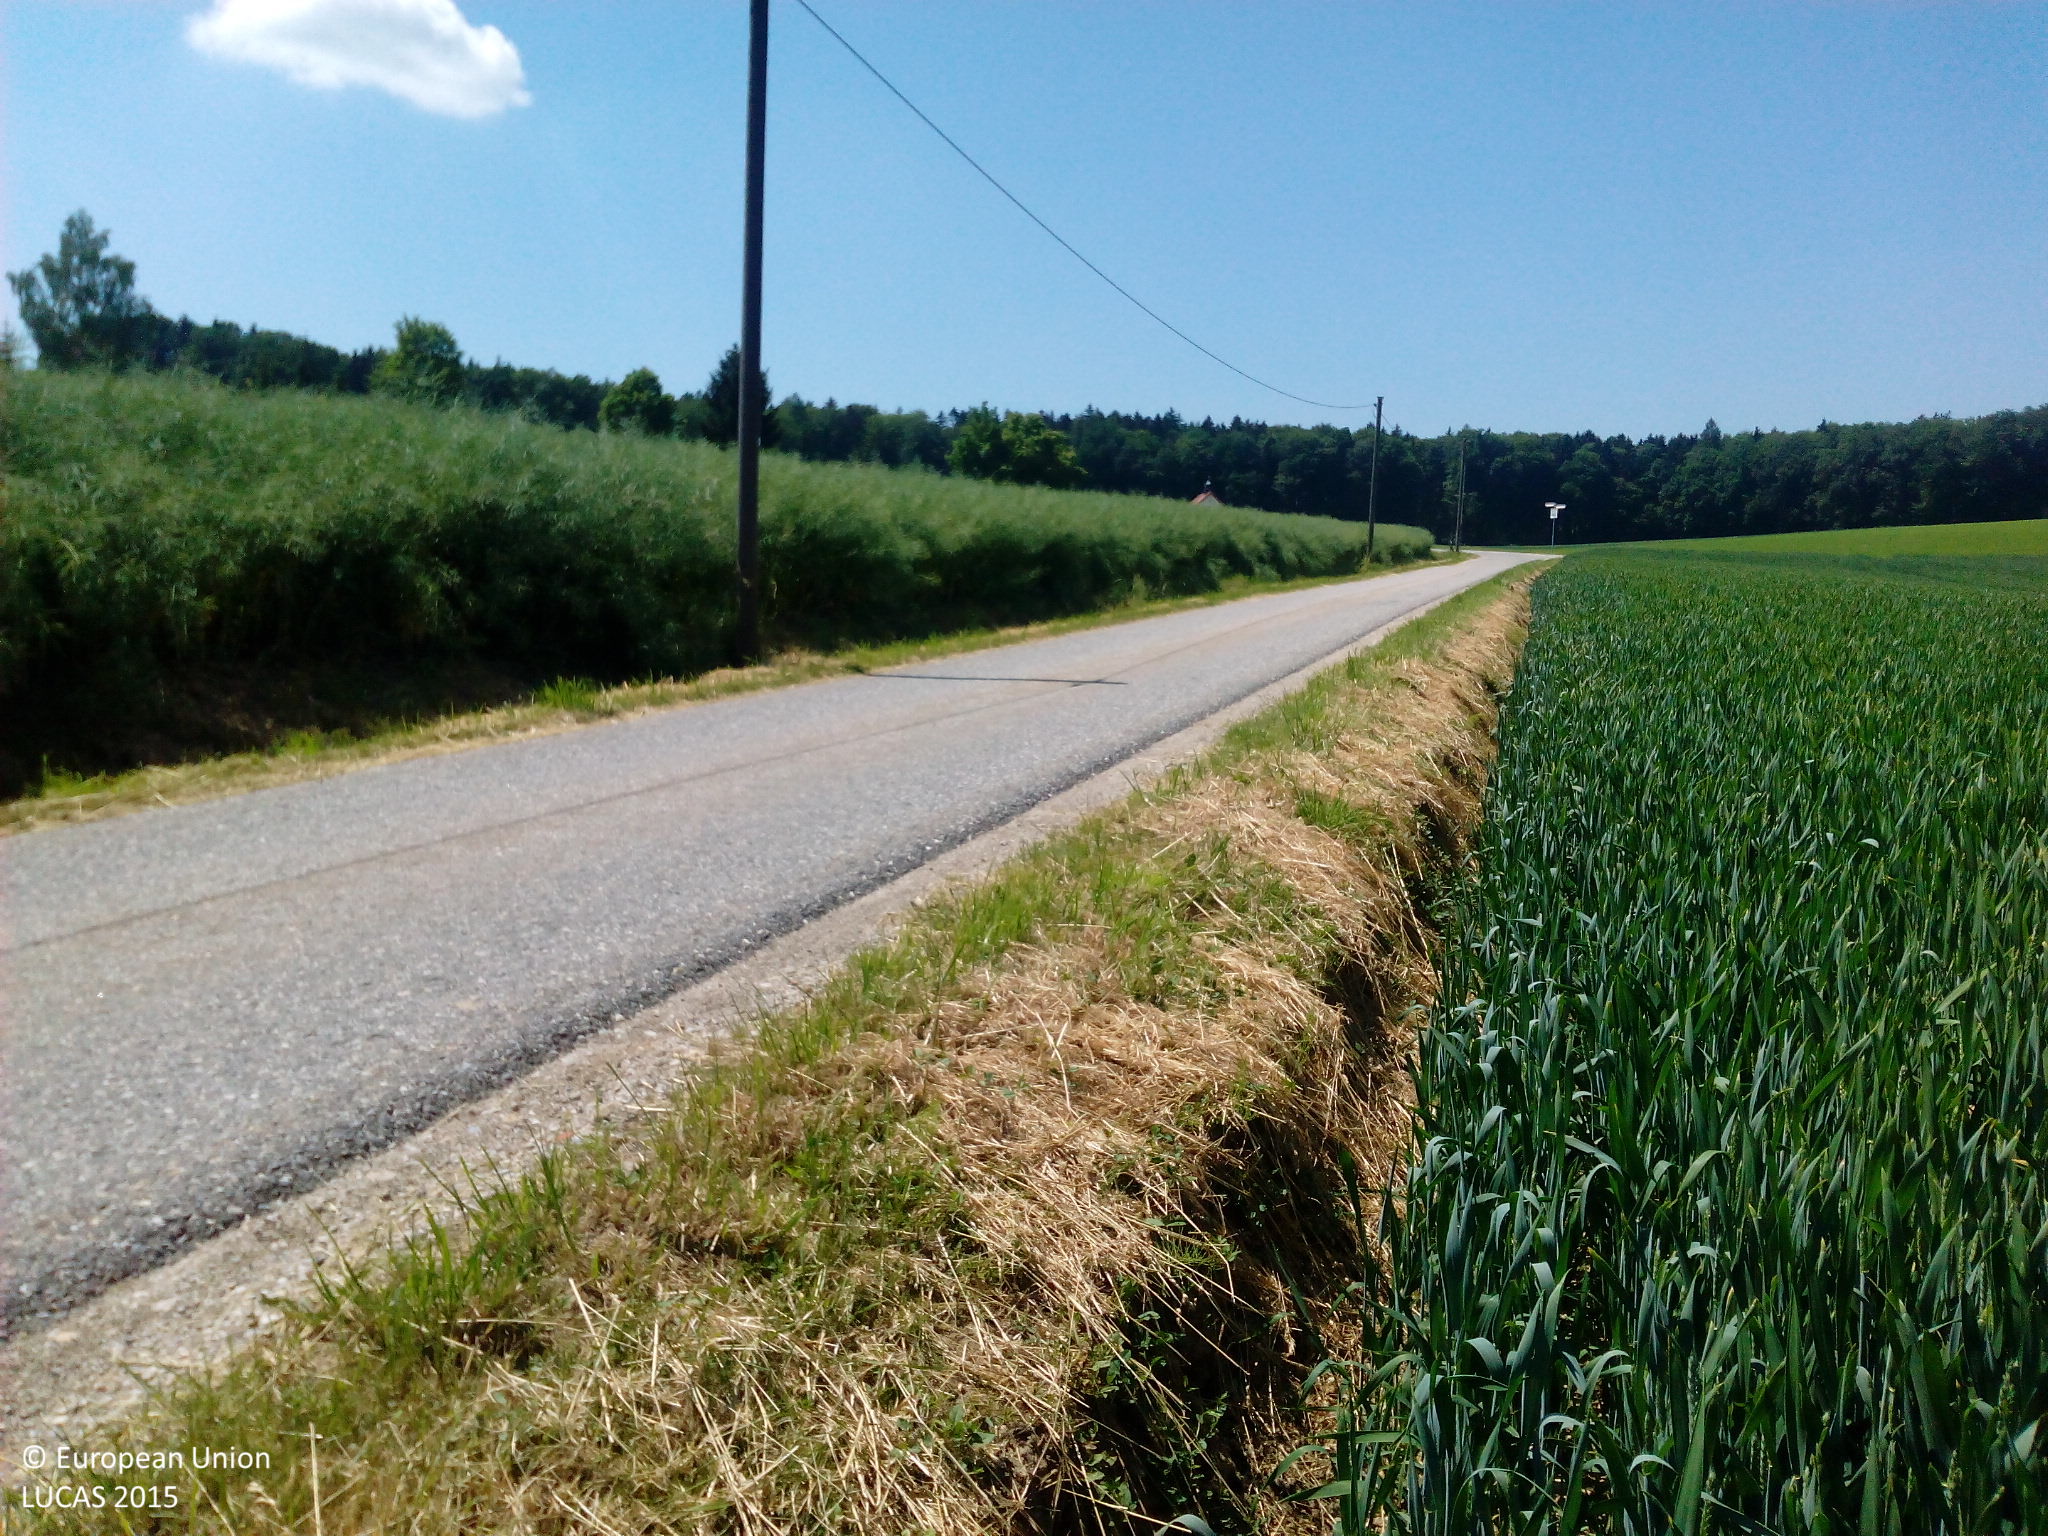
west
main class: Cropland
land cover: Common wheat
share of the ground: > 75 %
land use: Agriculture (excluding fallow land and kitchen gardens)
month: June
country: DE
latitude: 48.7553
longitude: 12.4069
